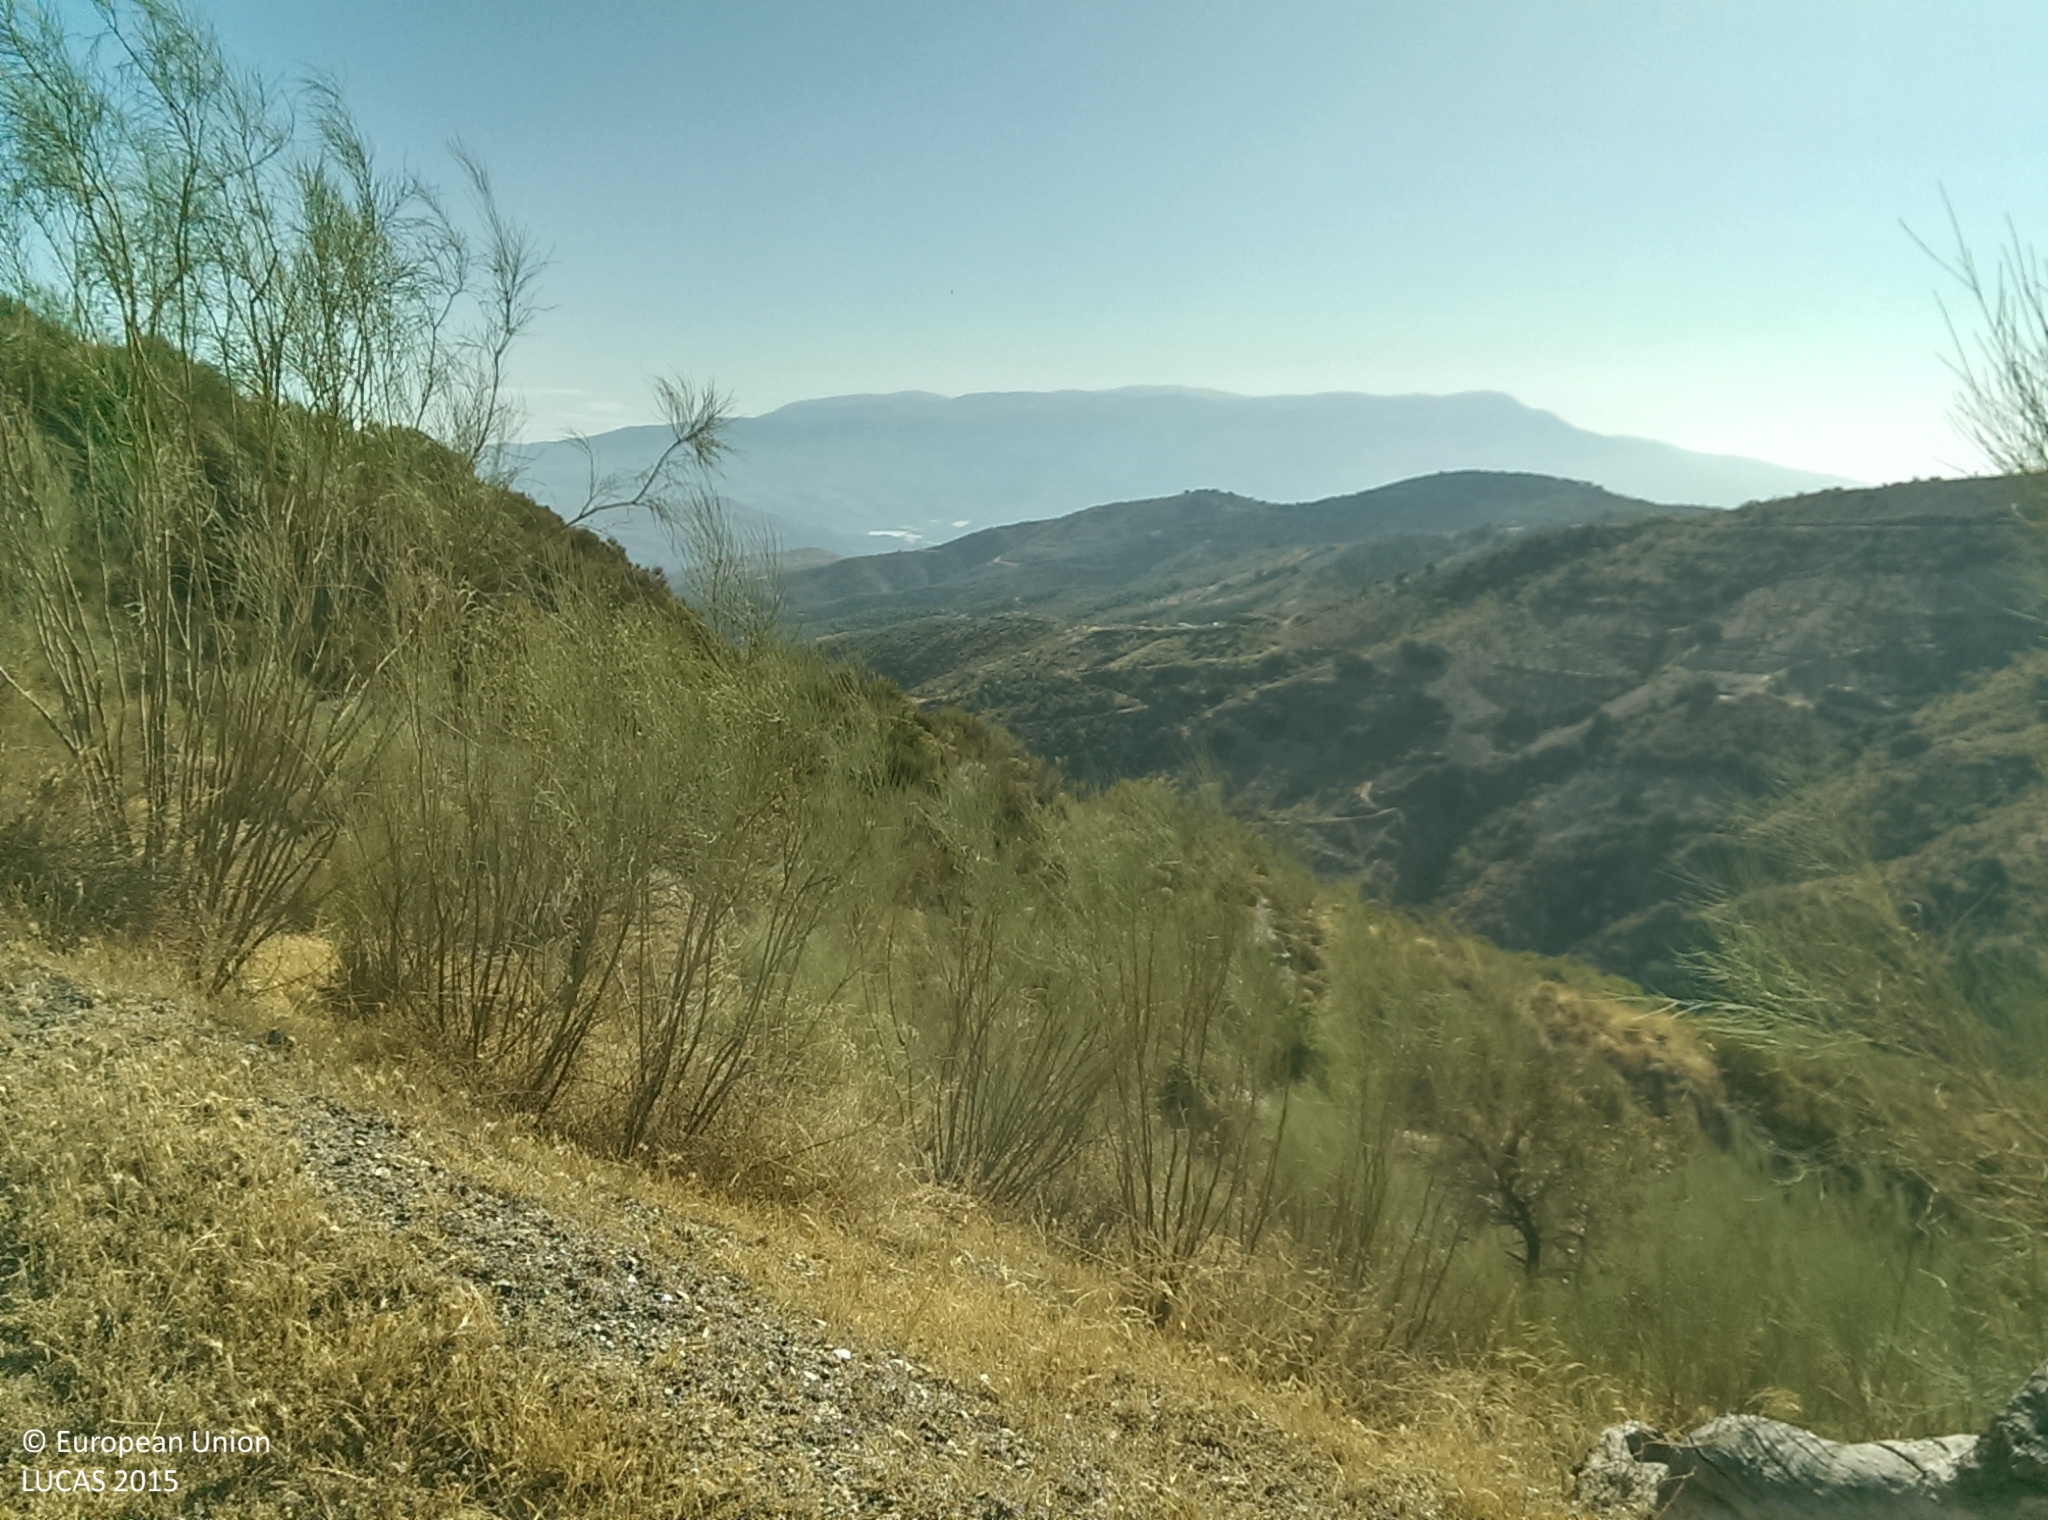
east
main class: Shrubland
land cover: Shrubland with sparse tree cover
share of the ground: 50 - 75 %
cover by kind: shrubs 60 %, herbaceous plants 30 %, coniferous forest trees 5 %, unconsolidated bare surface 5 %
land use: Semi-natural and natural areas not in use
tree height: < 5 m
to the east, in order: Shrubland with sparse tree cover; Tracks; Shrubland with sparse tree cover
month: August
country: ES
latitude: 36.8536
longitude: -3.1133
